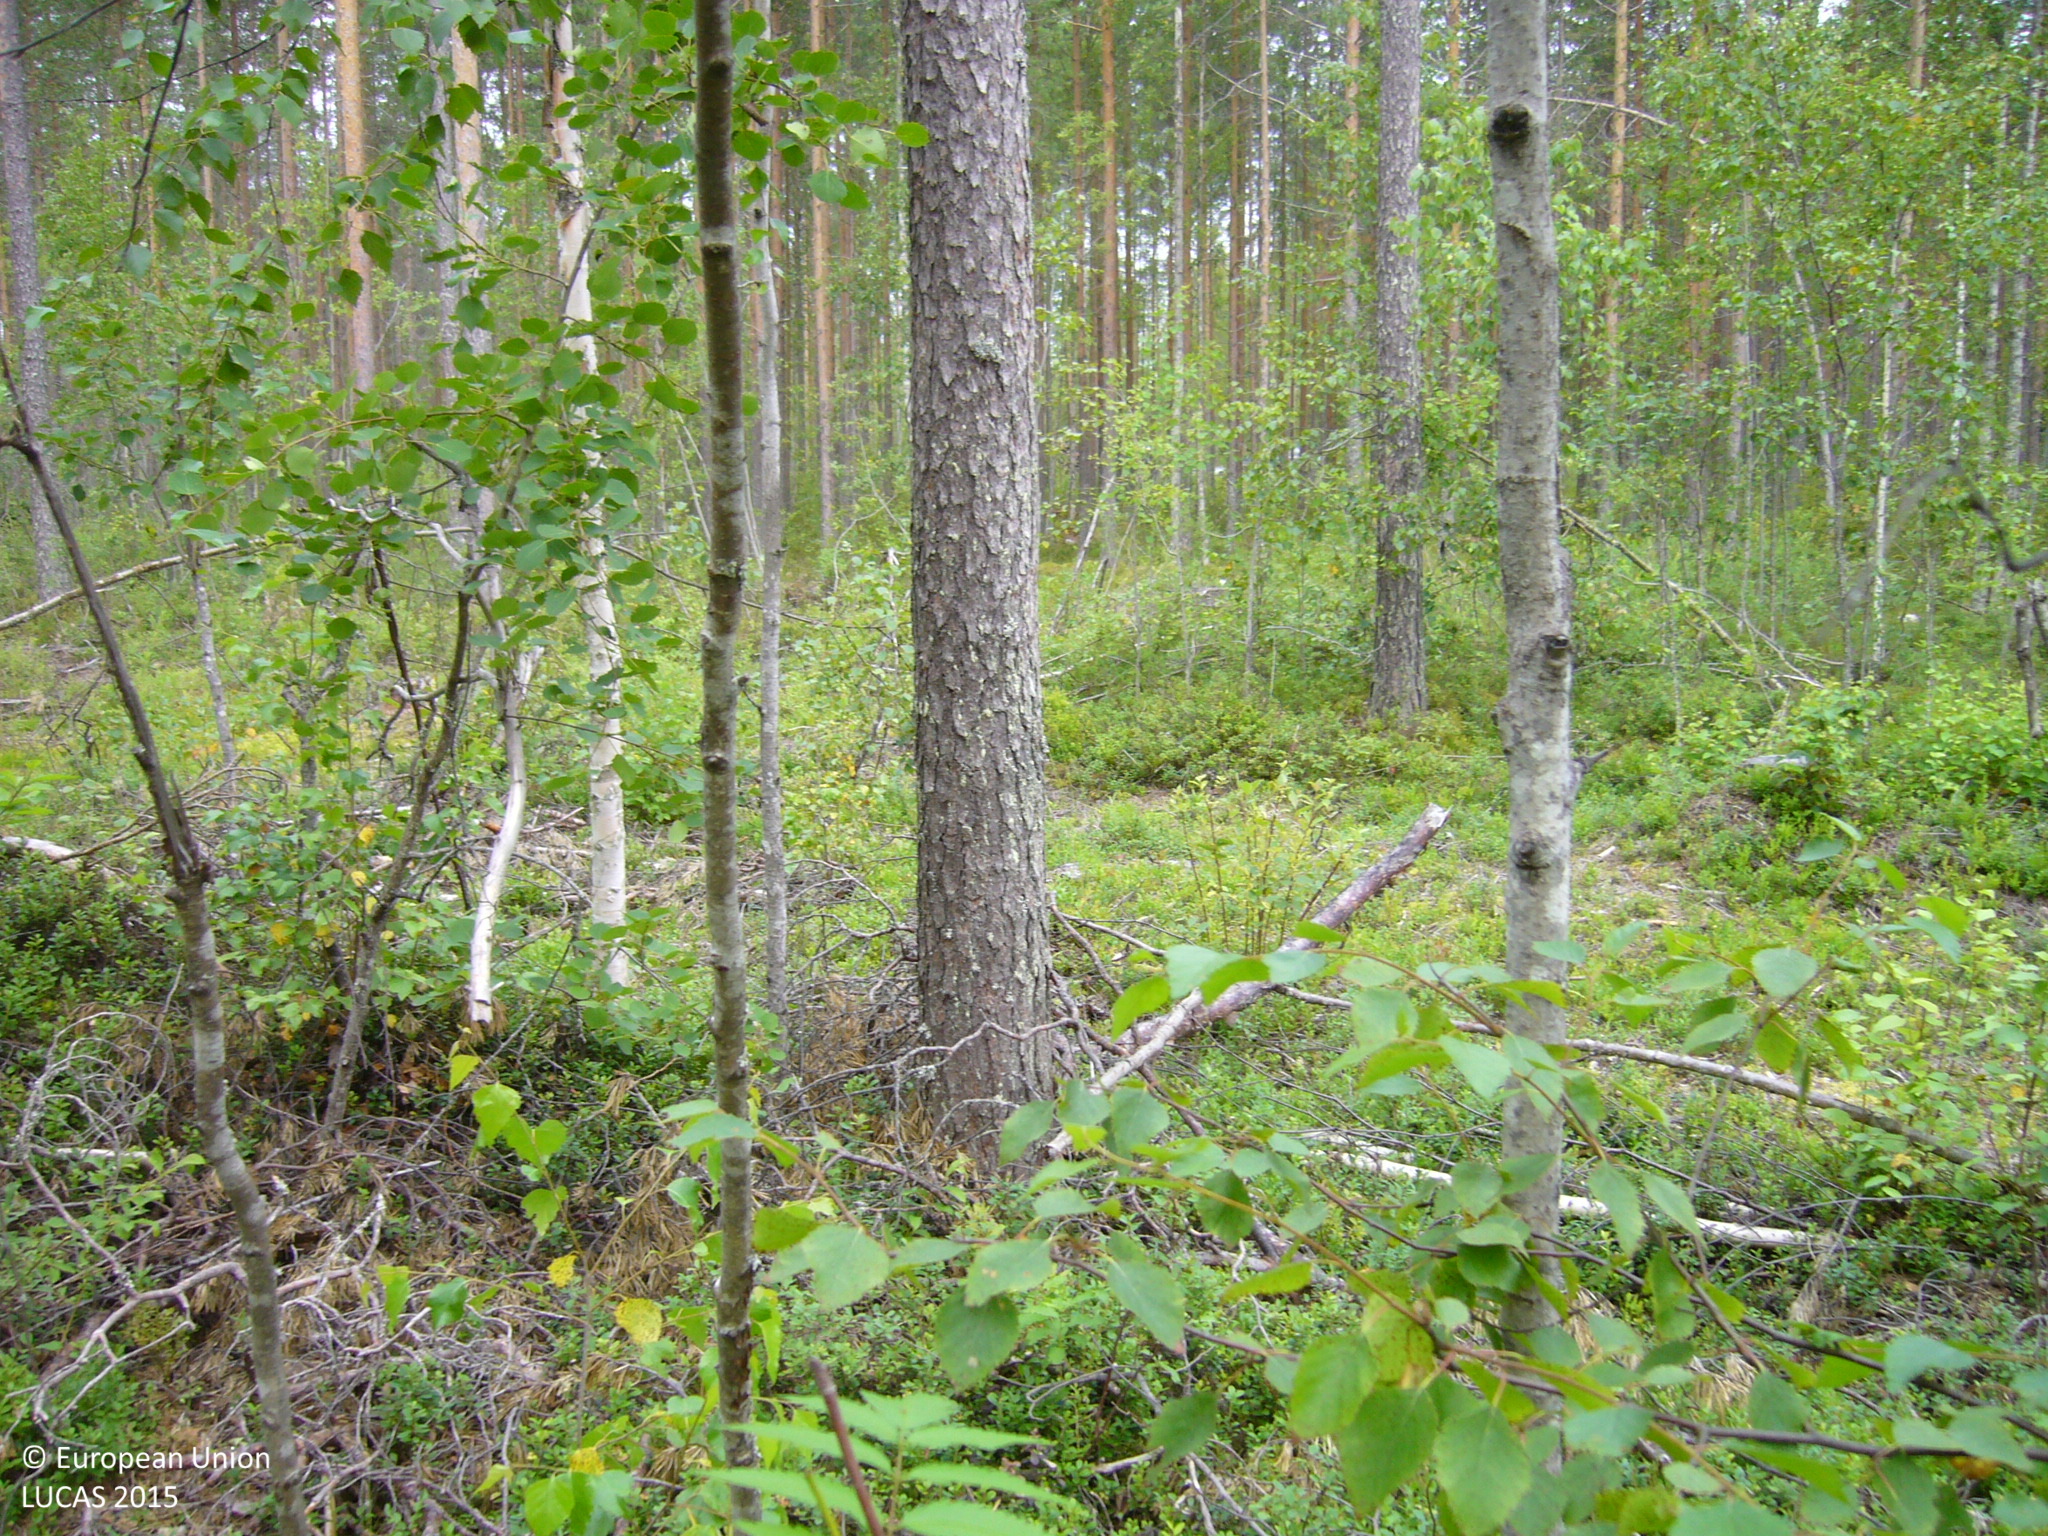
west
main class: Woodland
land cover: Pine dominated mixed woodland
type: boreal forest
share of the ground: 50 - 75 %
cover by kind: shrubs 50 %, broadleaved forest trees 30 %, coniferous forest trees 20 %
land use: Forestry
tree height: > 5 m
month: July
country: FI
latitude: 64.1309
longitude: 26.0269
